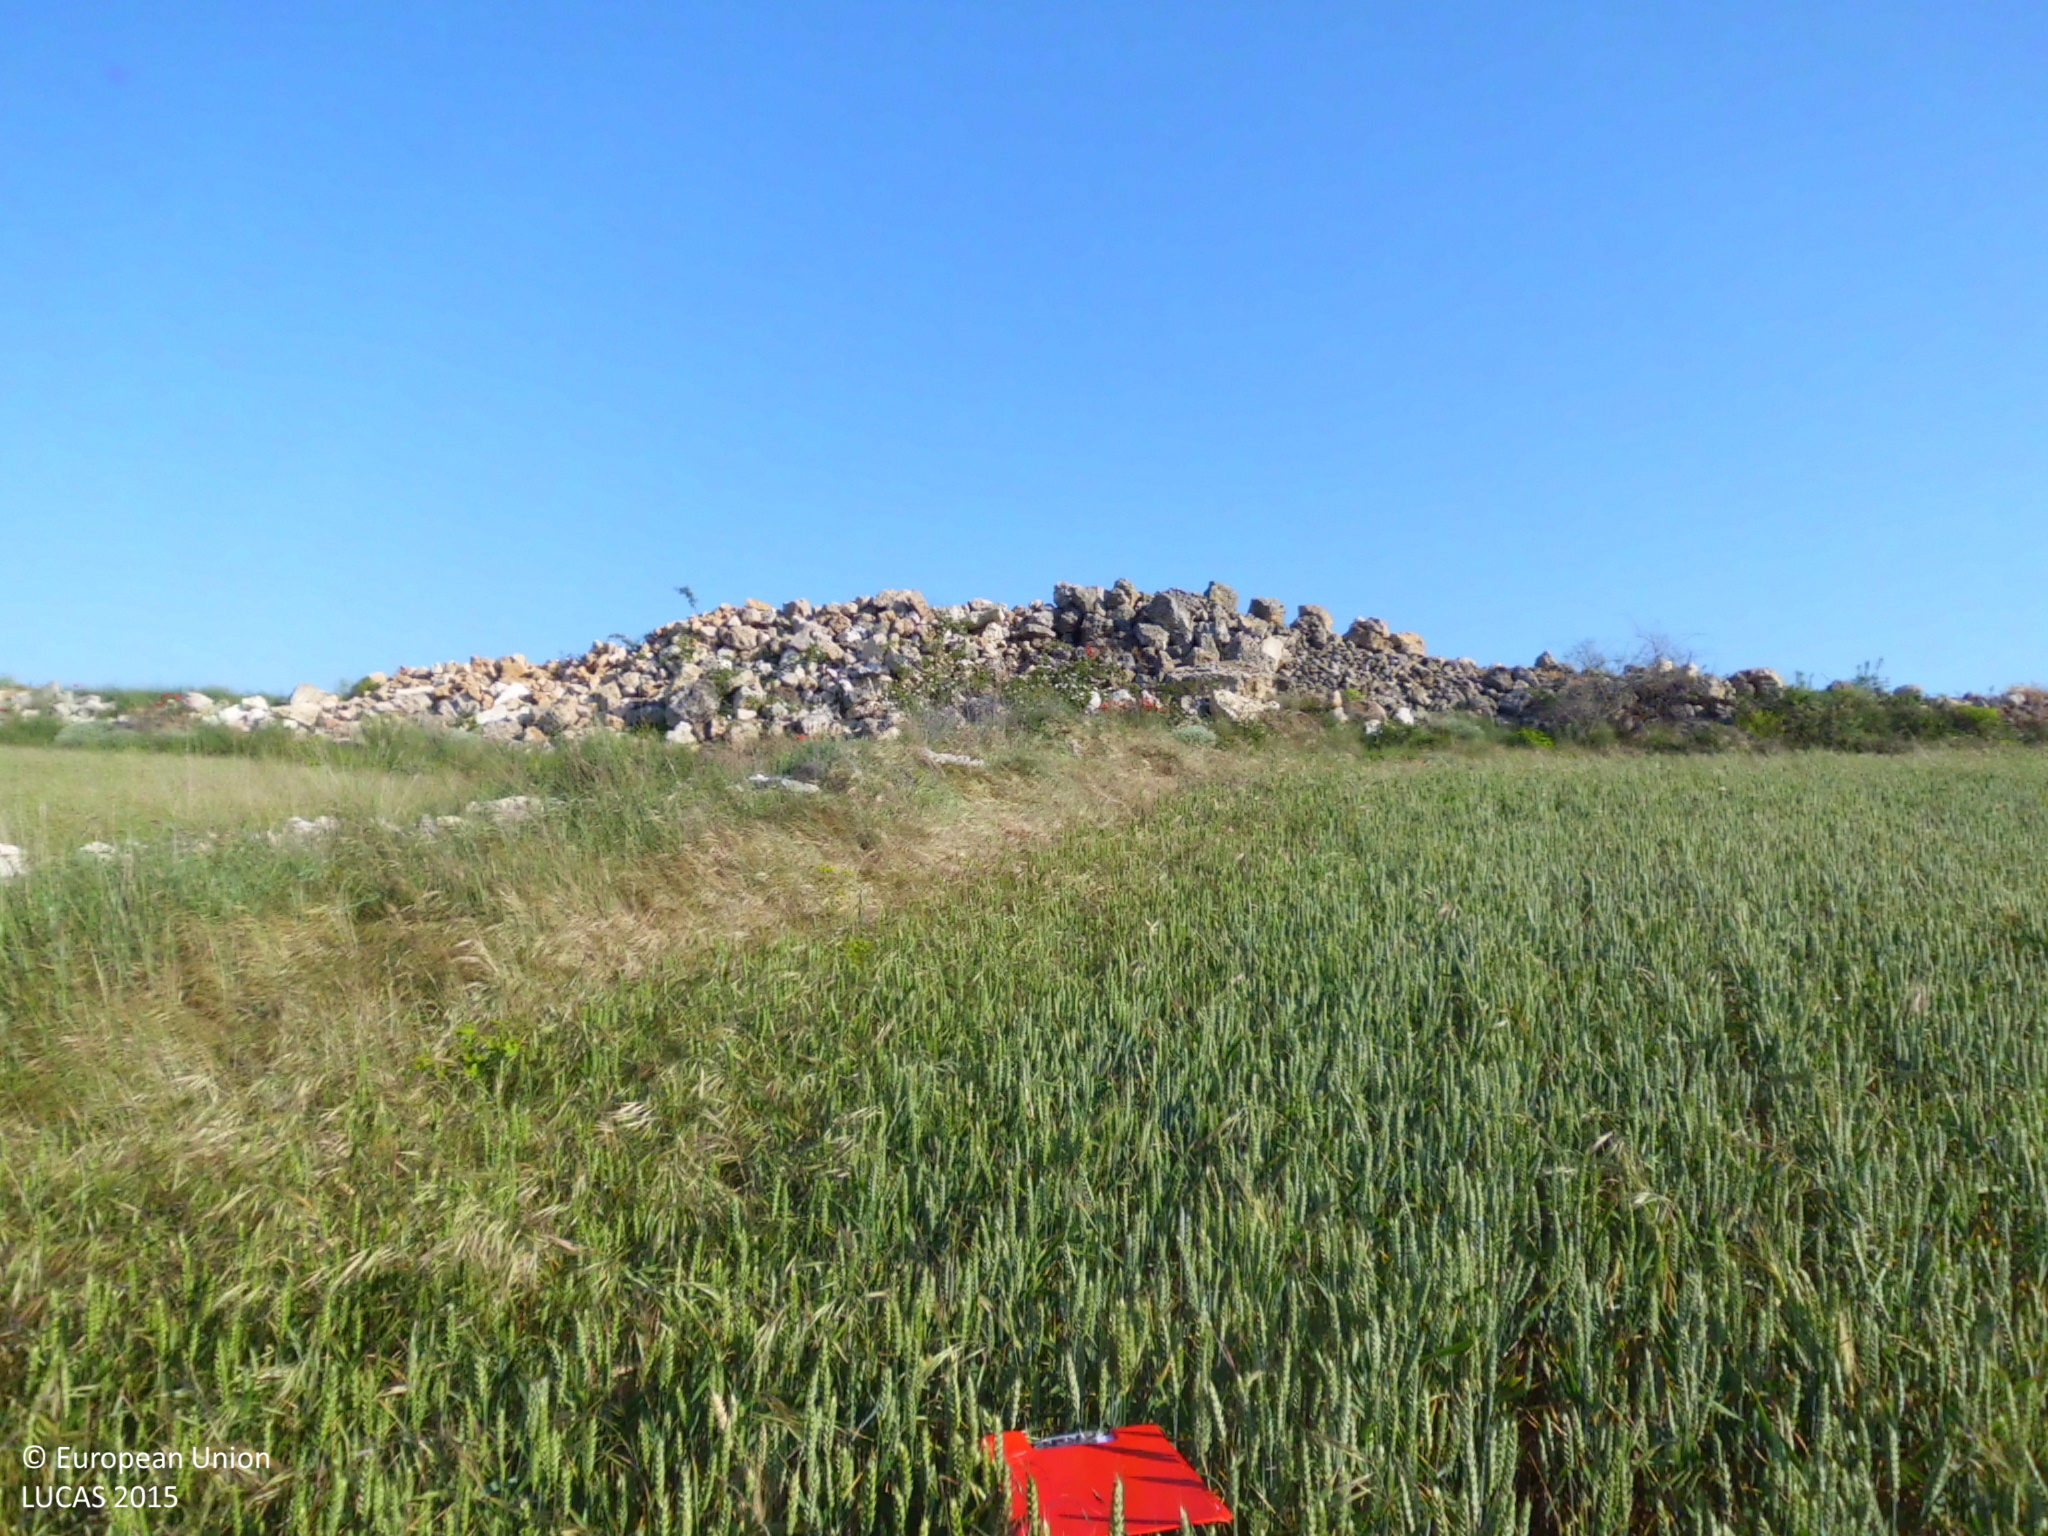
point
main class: Cropland
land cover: Common wheat
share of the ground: > 75 %
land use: Agriculture (excluding fallow land and kitchen gardens)
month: June
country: ES
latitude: 42.3404
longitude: -3.9622
